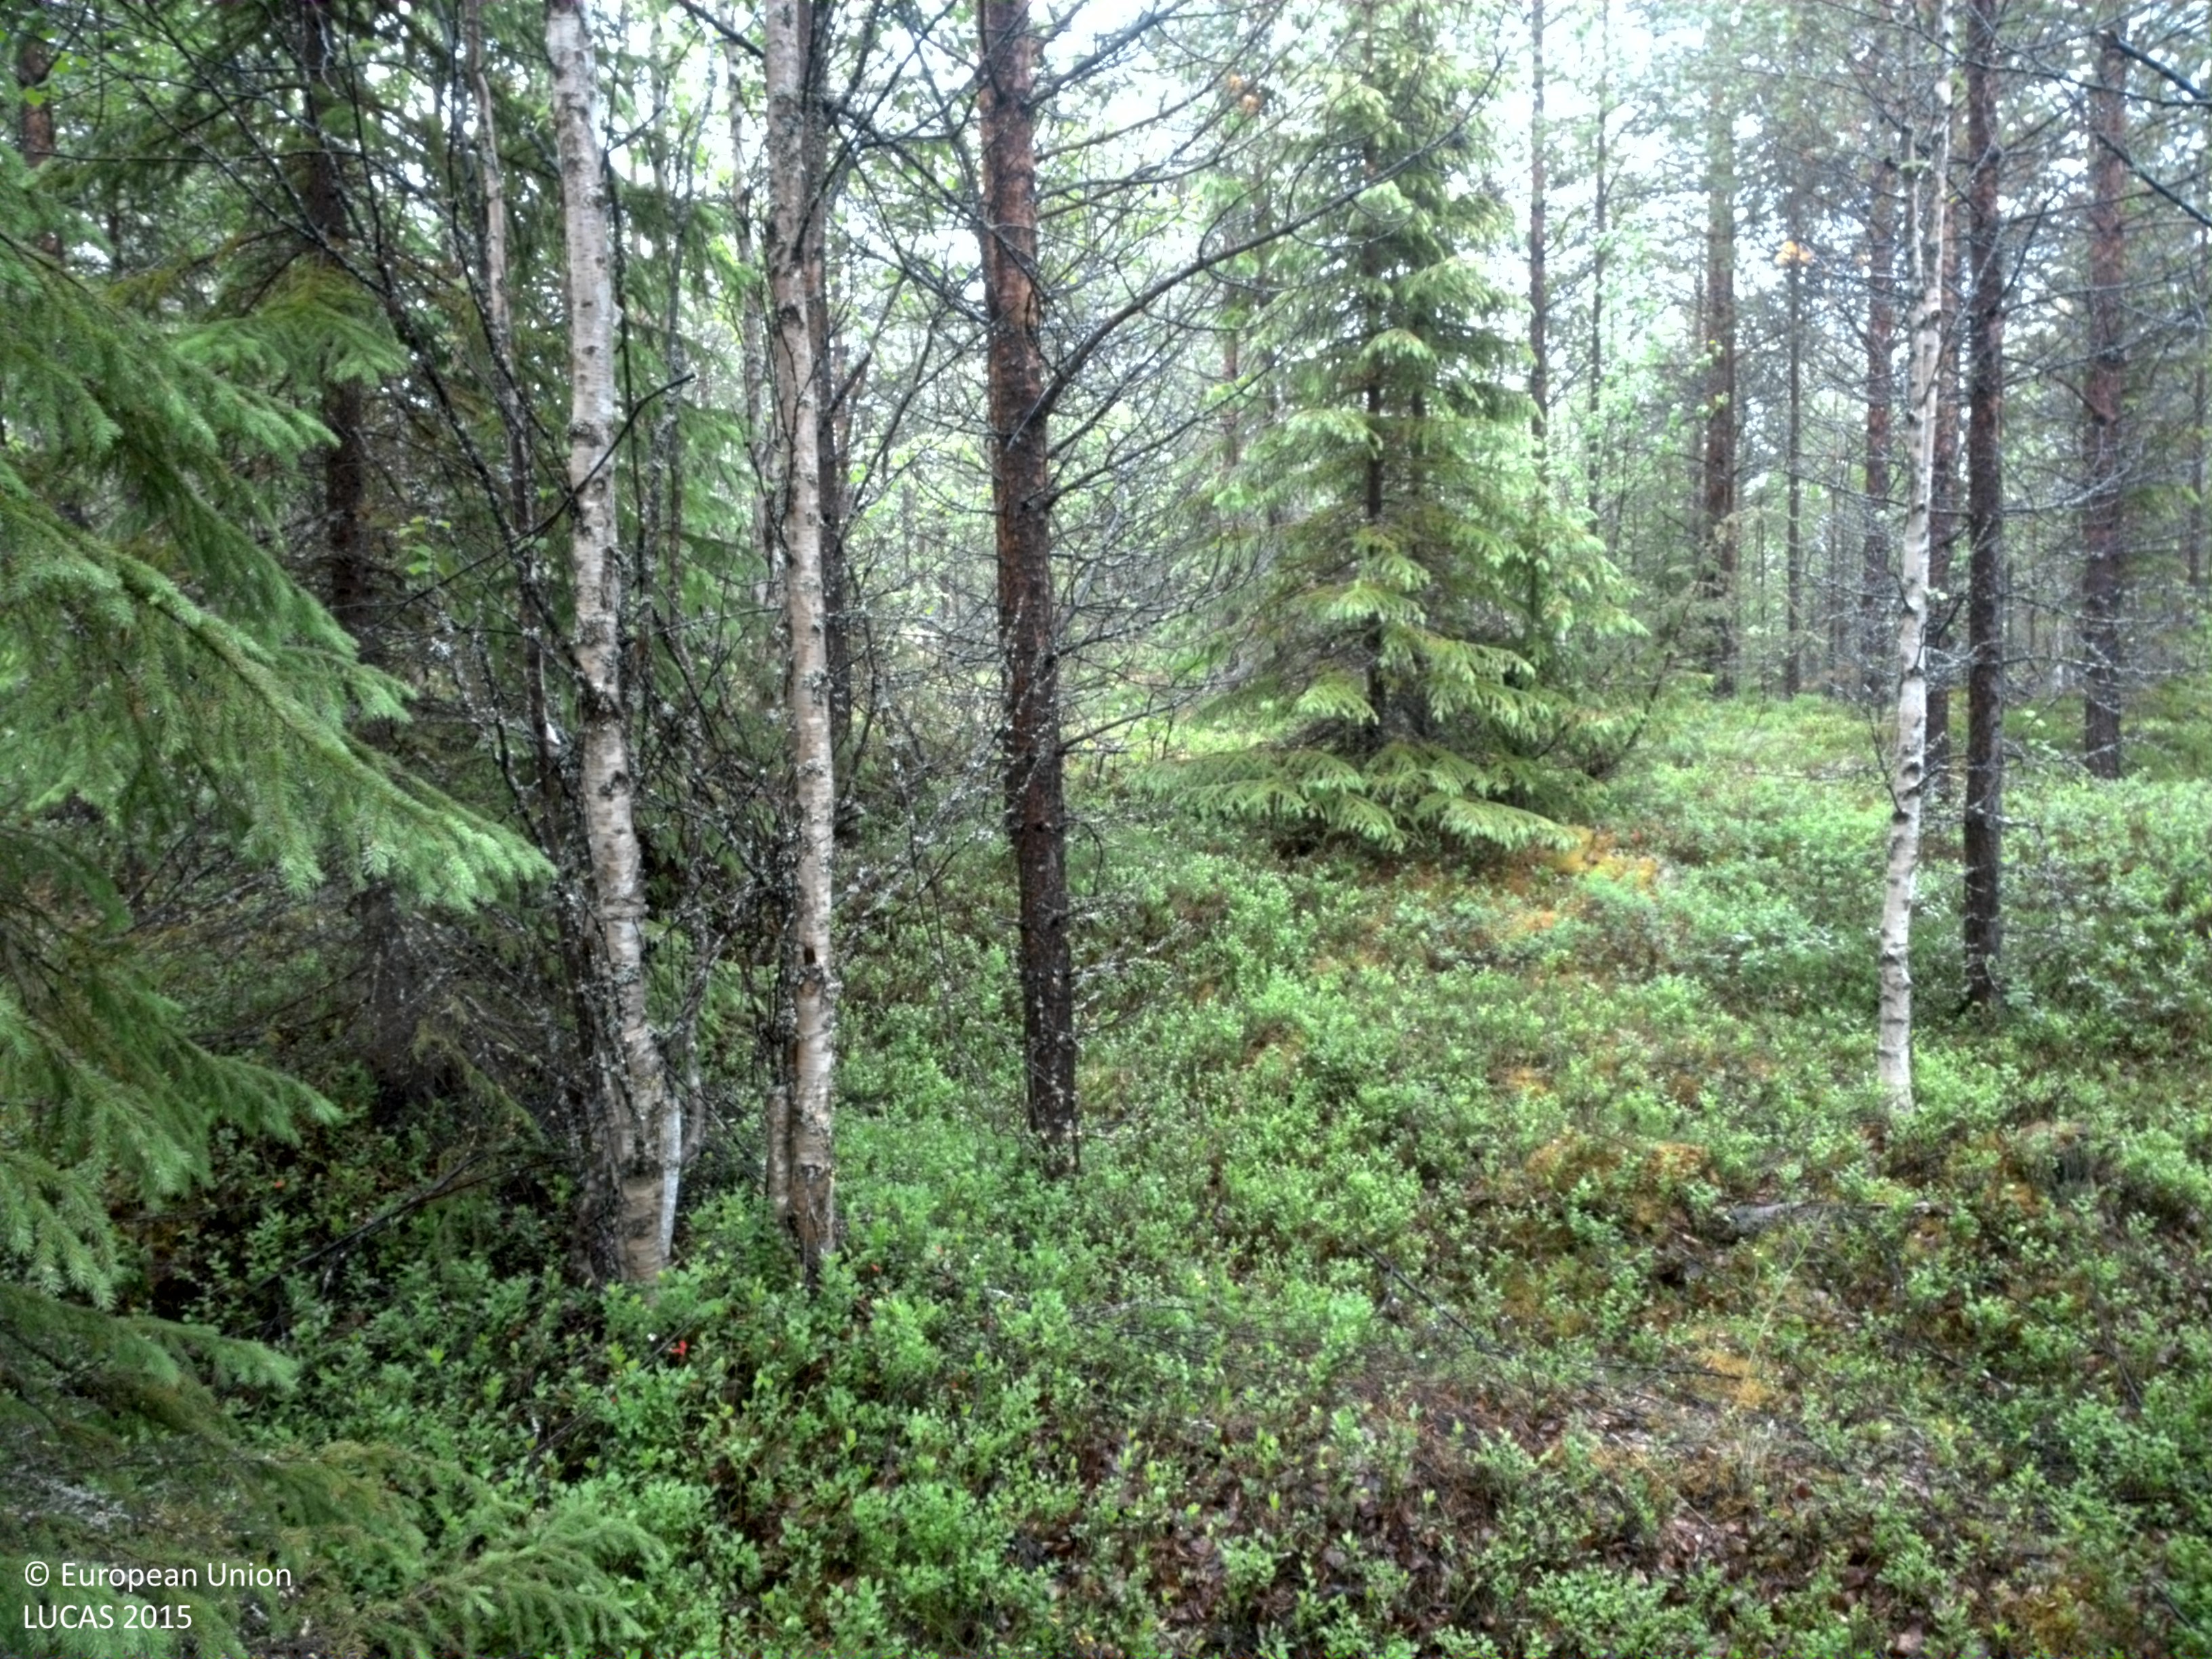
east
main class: Woodland
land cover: Other mixed woodland
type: boreal forest
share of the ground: 50 - 75 %
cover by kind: coniferous forest trees 45 %, shrubs 30 %, broadleaved forest trees 15 %, lichens and mosses 10 %
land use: Forestry
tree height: > 5 m
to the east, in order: Other mixed woodland; Spruce dominated mixed woodland; Other mixed woodland
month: July
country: SE
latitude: 64.5892
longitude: 18.1336
